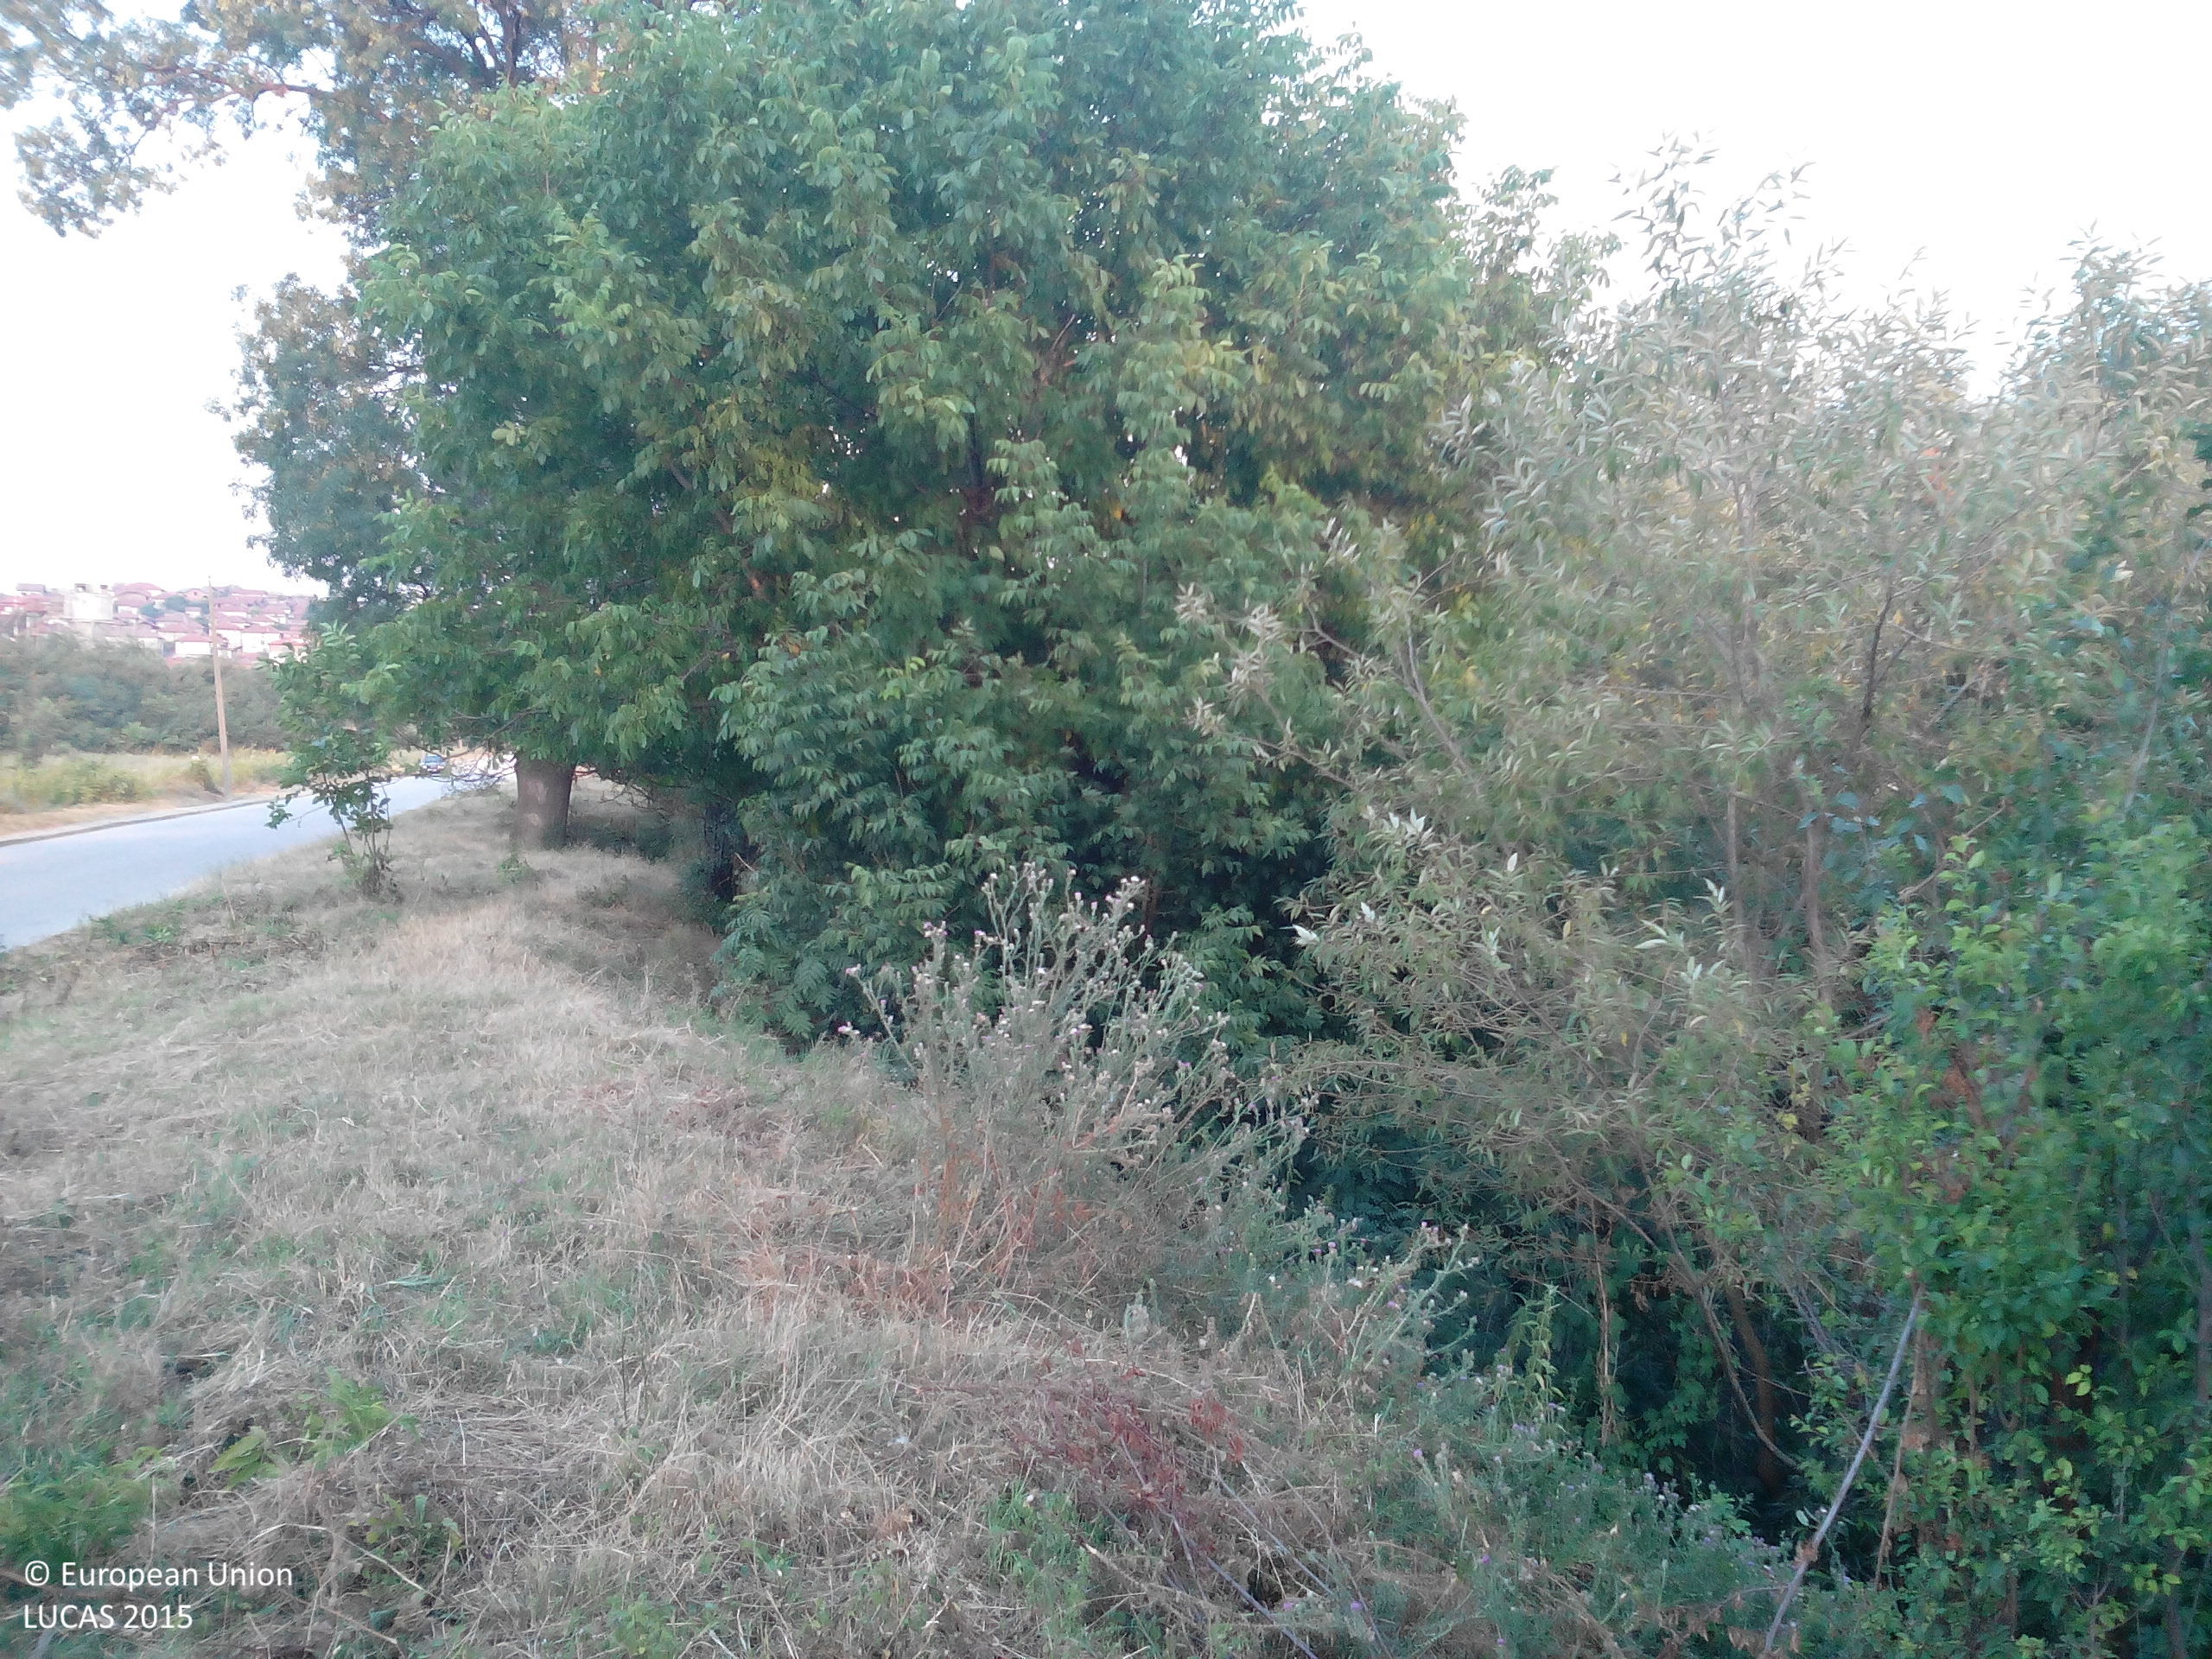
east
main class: Woodland
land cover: Broadleaved woodland
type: mesophytic deciduous forest
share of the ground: 25 - 50 %
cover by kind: broadleaved forest trees 45 %, herbaceous plants 30 %, shrubs 20 %
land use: Amenities, museums, leisure
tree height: > 5 m
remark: Temporary dry
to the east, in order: Broadleaved woodland; Inland fresh running water; Broadleaved woodland; Grassland without tree/shrub cover; Paved roads, cycling and walking lanes; Shrubland without tree cover; Grassland with sparse tree/shrub cover; Broadleaved woodland
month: July
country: BG
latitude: 43.2077
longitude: 24.1704
